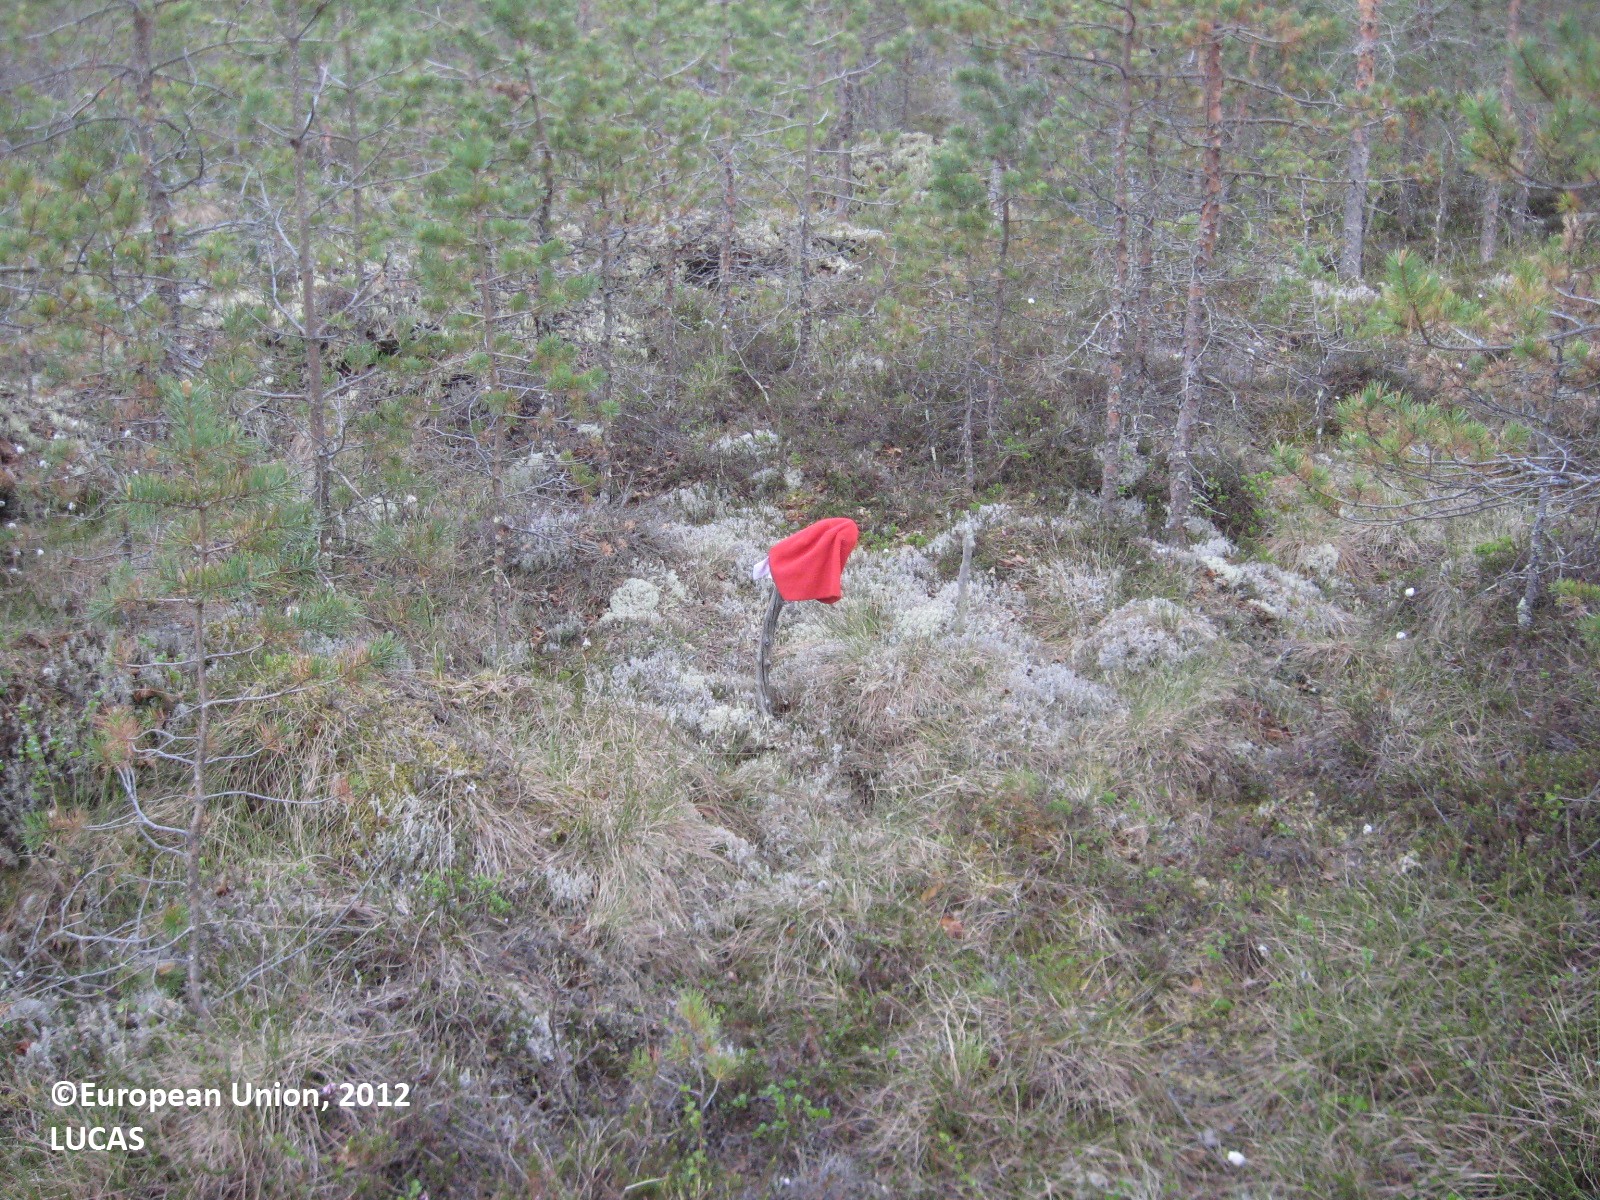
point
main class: Woodland
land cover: Pine dominated coniferous woodland
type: boreal forest
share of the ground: 50 - 75 %
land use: Forestry
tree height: < 5 m
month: June
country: FI
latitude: 63.4534
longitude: 22.8273
